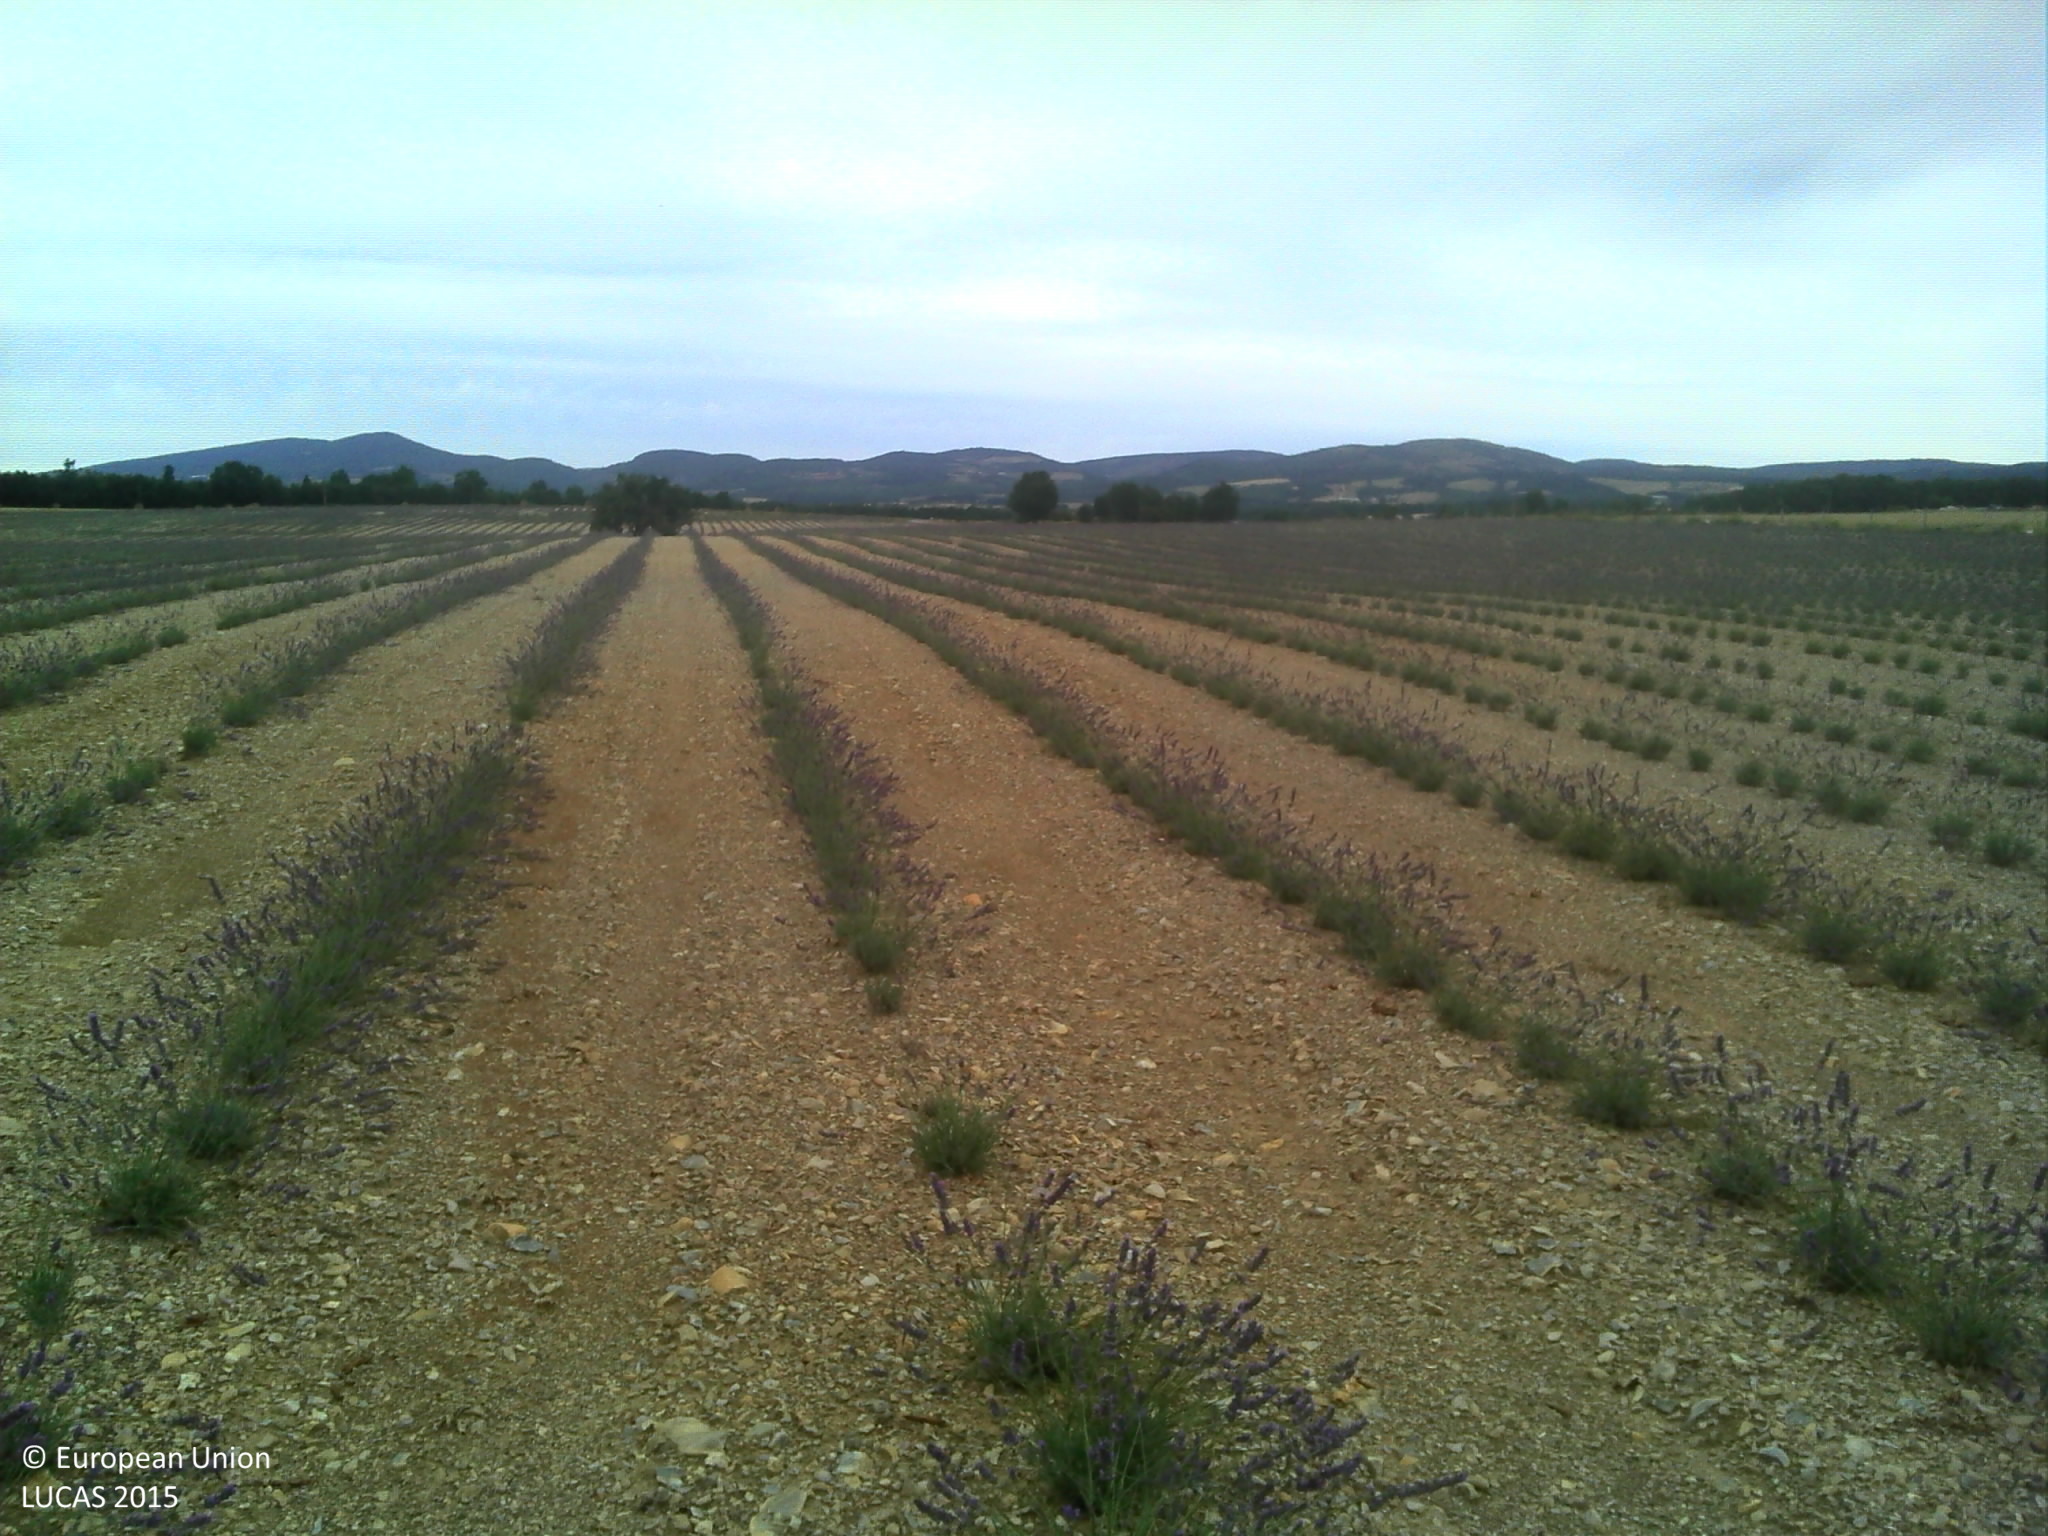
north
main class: Cropland
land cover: Permanent industrial crops
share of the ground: 10 - 25 %
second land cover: Other bare soil
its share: > 75 %
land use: Agriculture (excluding fallow land and kitchen gardens)
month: July
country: FR
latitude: 44.0735
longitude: 5.5255
